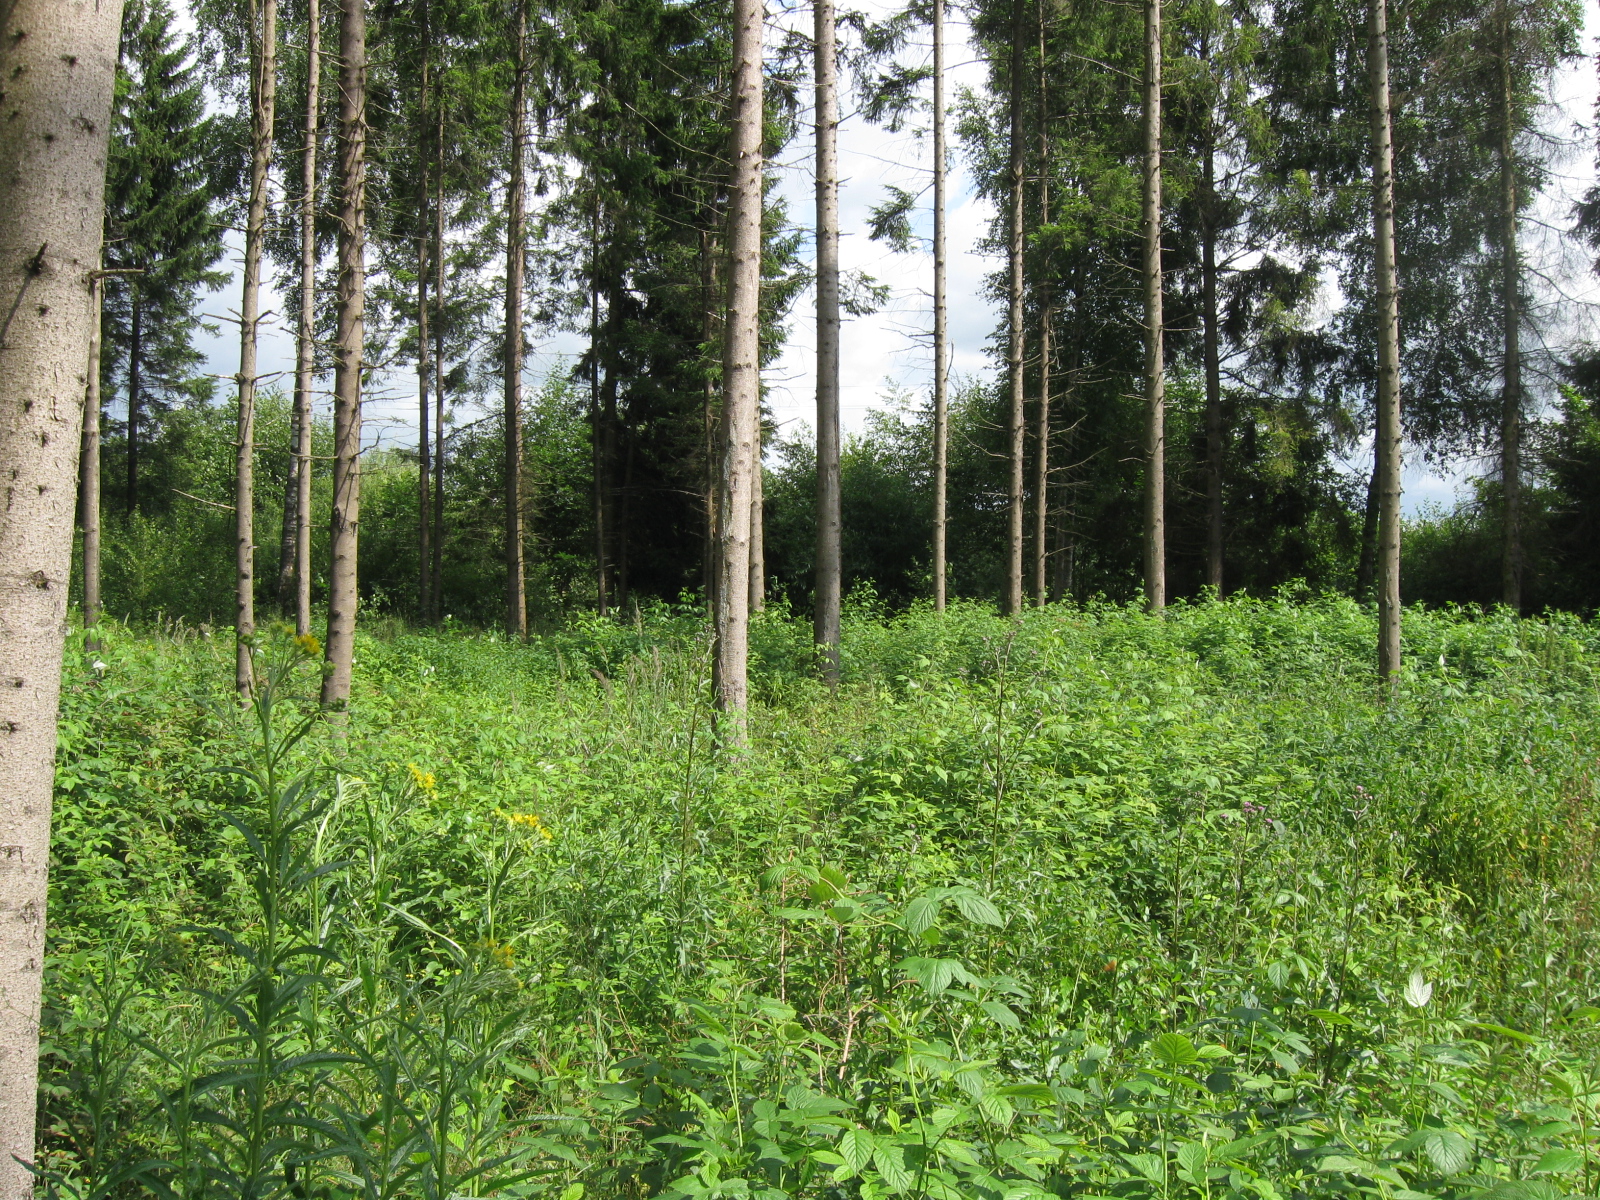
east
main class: Shrubland
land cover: Shrubland with sparse tree cover
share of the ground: 50 - 75 %
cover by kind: herbaceous plants 50 %, shrubs 45 %, coniferous forest trees 5 %
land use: Forestry
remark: Clear cut
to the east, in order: Shrubland with sparse tree cover; Spruce dominated coniferous woodland; Other mixed woodland; Ditches and canals; Broadleaved woodland; Tracks; Electric lines; Grassland without tree/shrub cover; Broadleaved woodland; Electric lines; Grassland with sparse tree/shrub cover; Other fruit trees and berries; Broadleaved woodland; Grassland with sparse tree/shrub cover
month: July
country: LT
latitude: 55.1277
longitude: 23.4569
